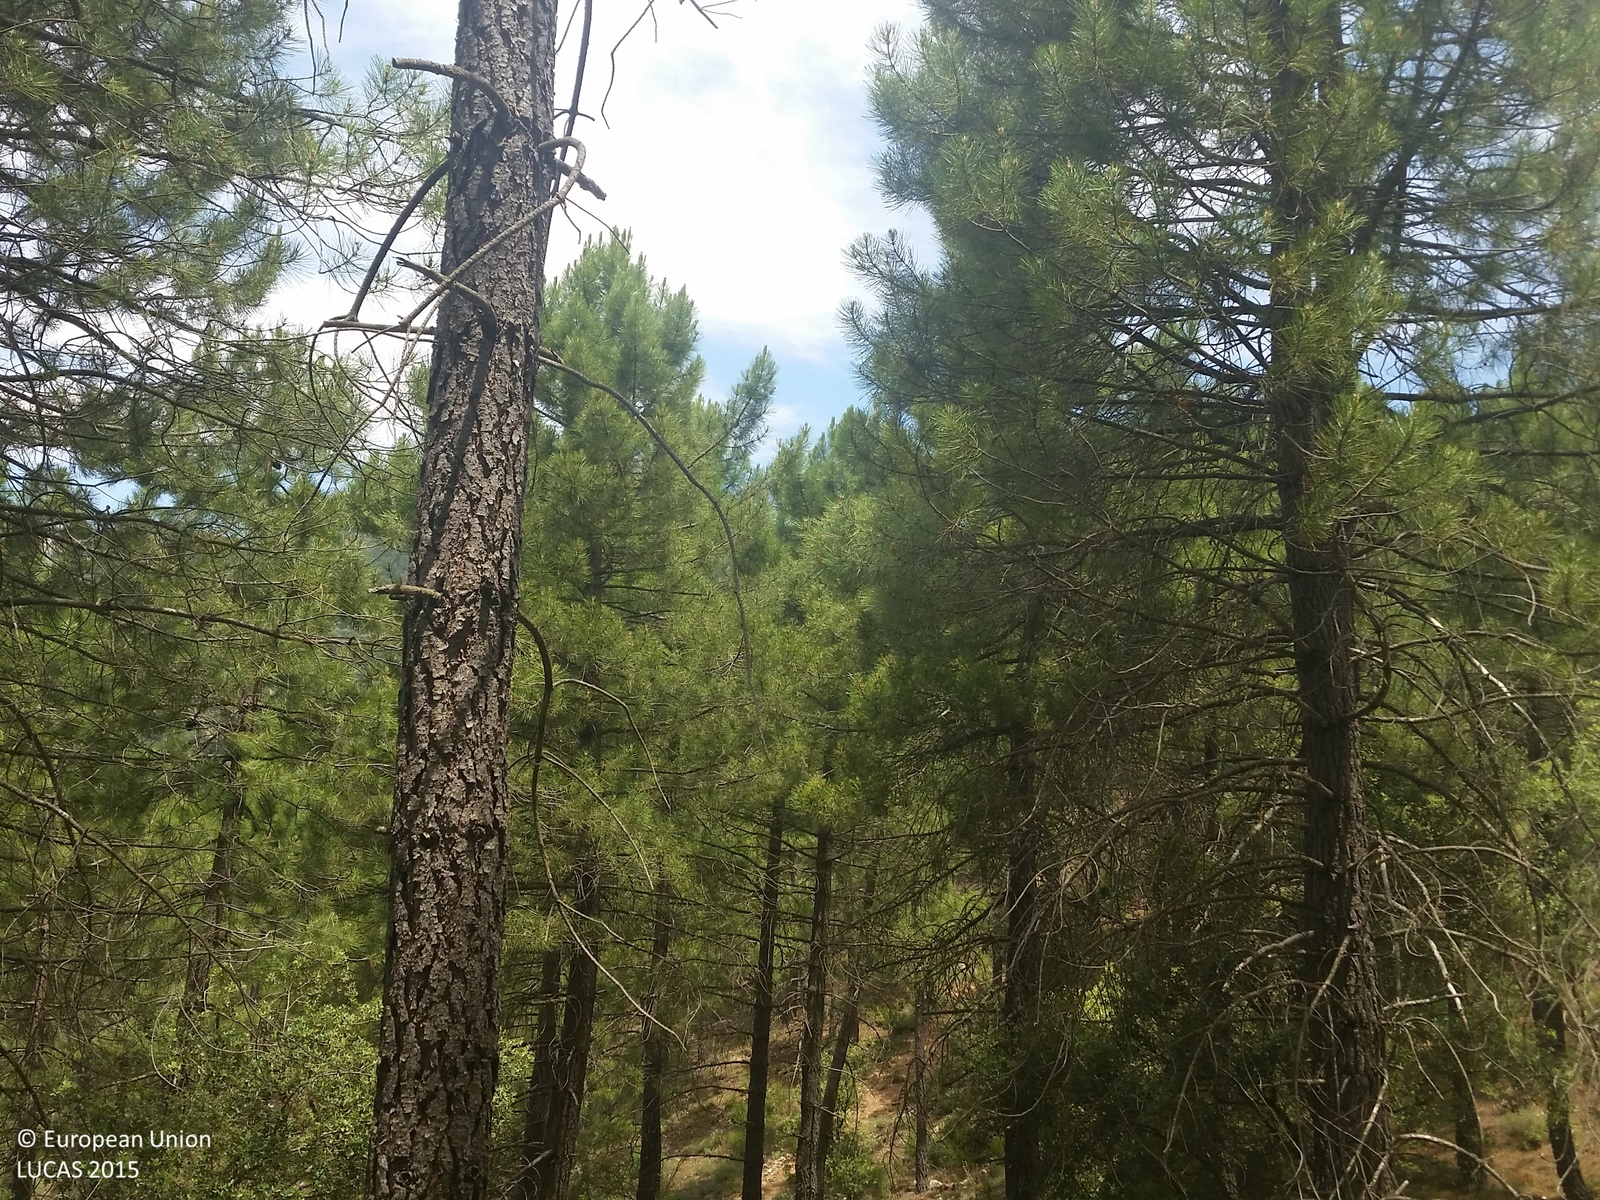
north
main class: Woodland
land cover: Pine dominated coniferous woodland
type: coniferous forest of the mediterranean region
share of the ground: > 75 %
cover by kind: coniferous forest trees 100 %
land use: Forestry
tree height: > 5 m
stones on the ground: 10 - 25 %
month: June
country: ES
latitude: 38.5204
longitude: -2.4434
